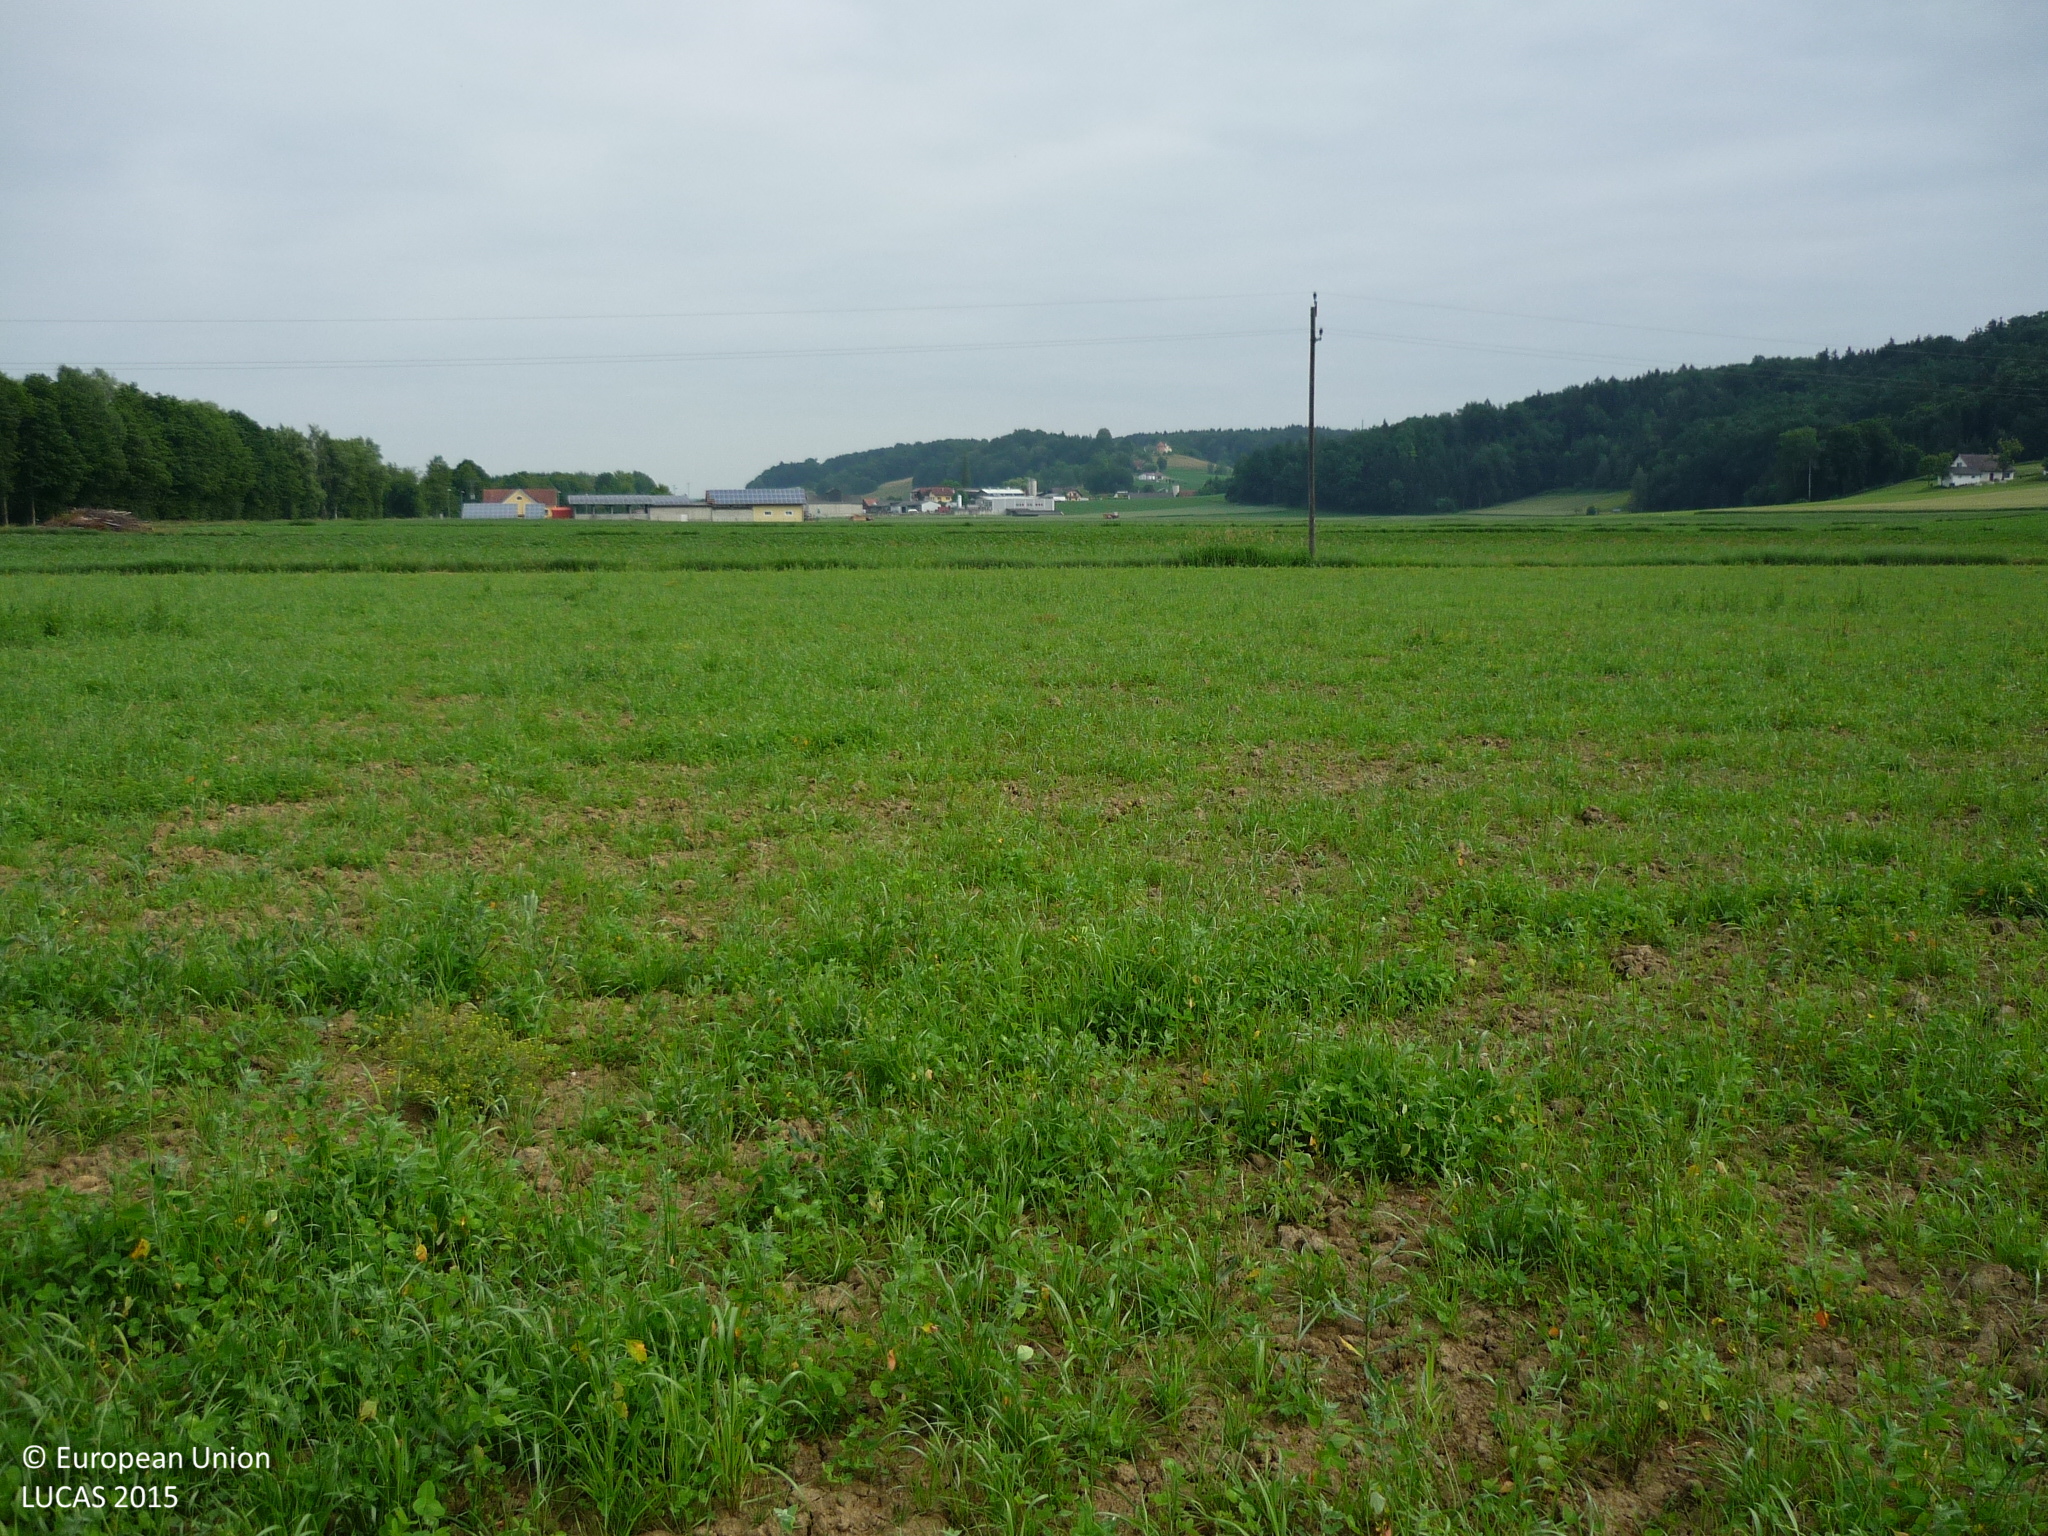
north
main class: Cropland
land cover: Temporary grasslands
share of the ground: > 75 %
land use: Agriculture (excluding fallow land and kitchen gardens)
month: June
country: AT
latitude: 46.7978
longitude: 15.6466
